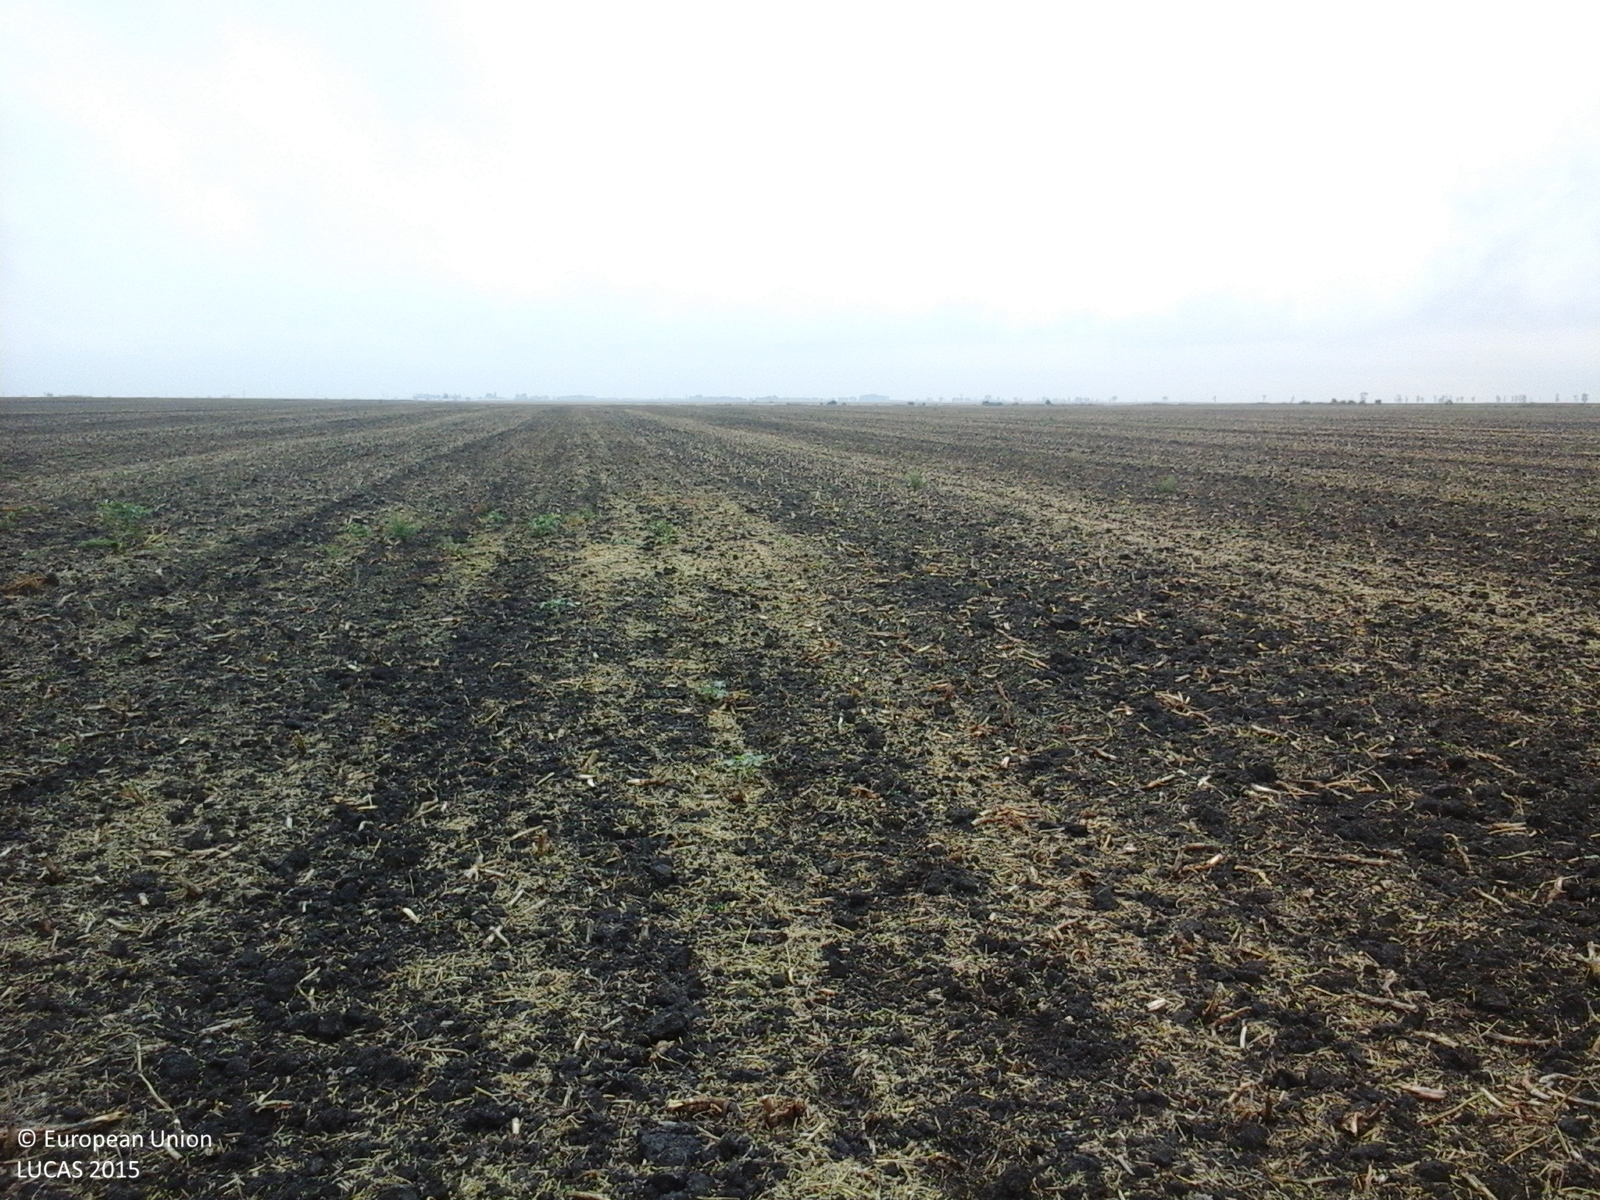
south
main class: Cropland
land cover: Rape and turnip rape
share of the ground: < 10 %
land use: Agriculture (excluding fallow land and kitchen gardens)
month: August
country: RO
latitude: 45.8492
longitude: 20.7008
